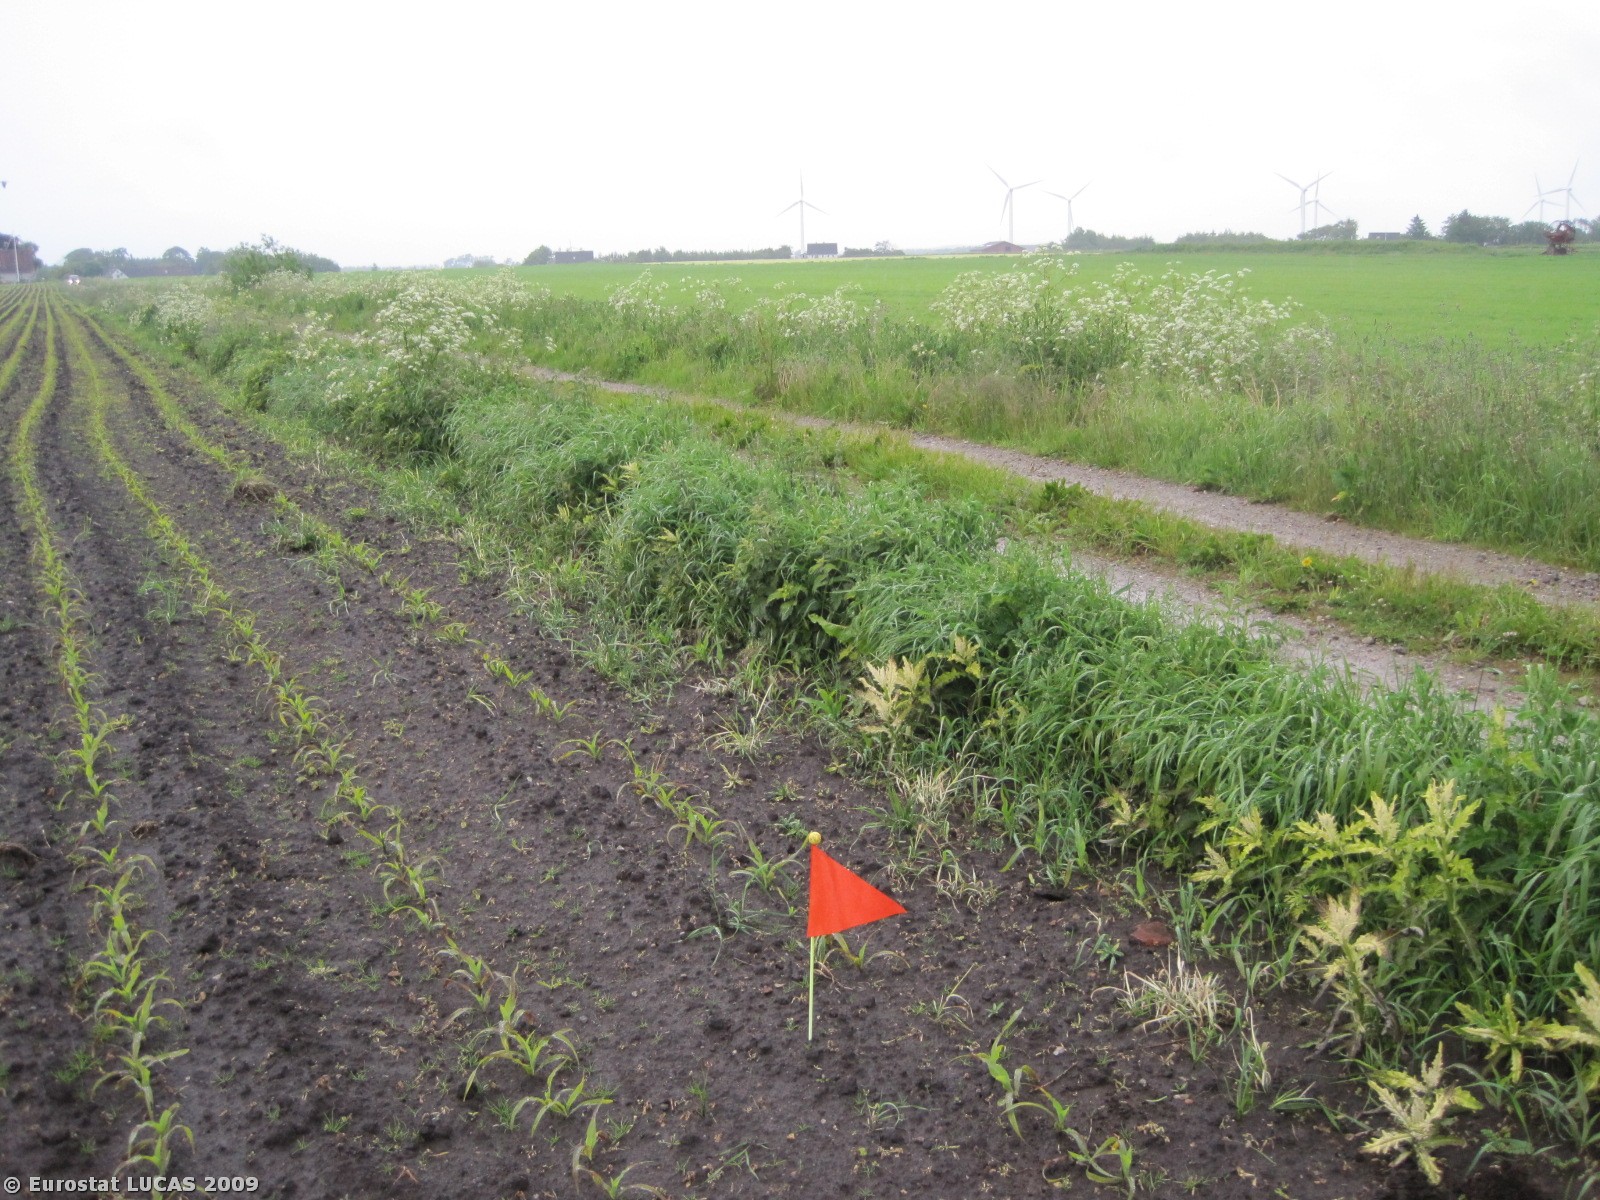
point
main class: Cropland
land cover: Maize
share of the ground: < 10 %
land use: Agriculture (excluding fallow land and kitchen gardens)
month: June
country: DK
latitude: 57.3922
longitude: 10.0831
